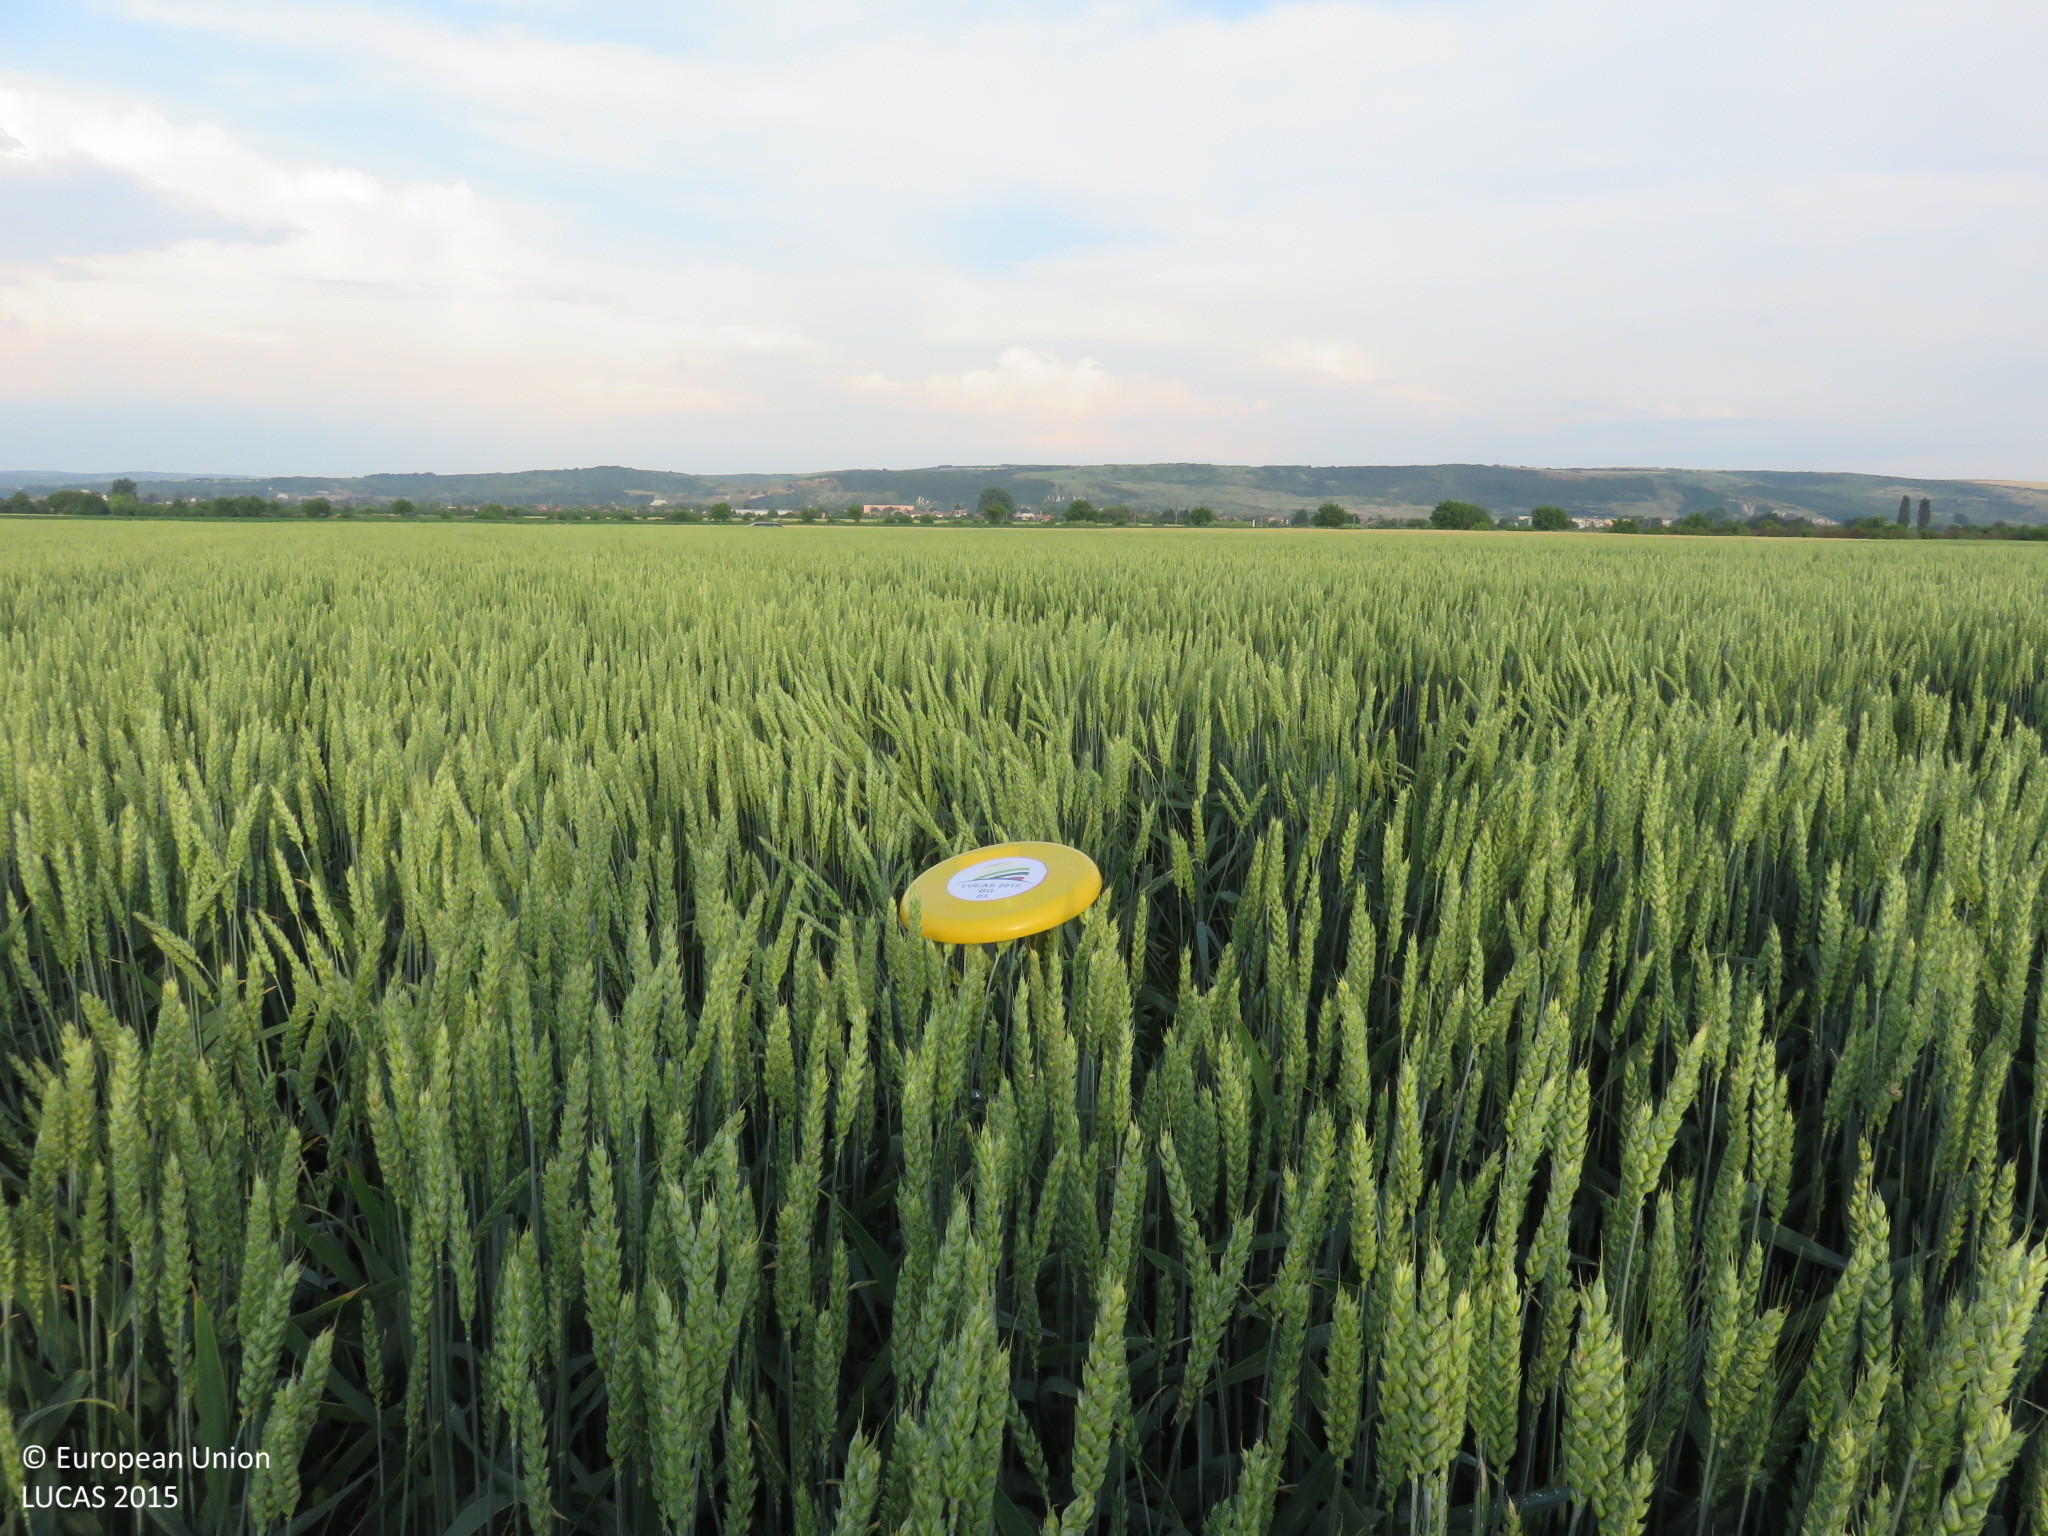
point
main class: Cropland
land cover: Common wheat
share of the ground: > 75 %
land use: Agriculture (excluding fallow land and kitchen gardens)
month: June
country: BG
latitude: 43.4351
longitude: 24.5032
